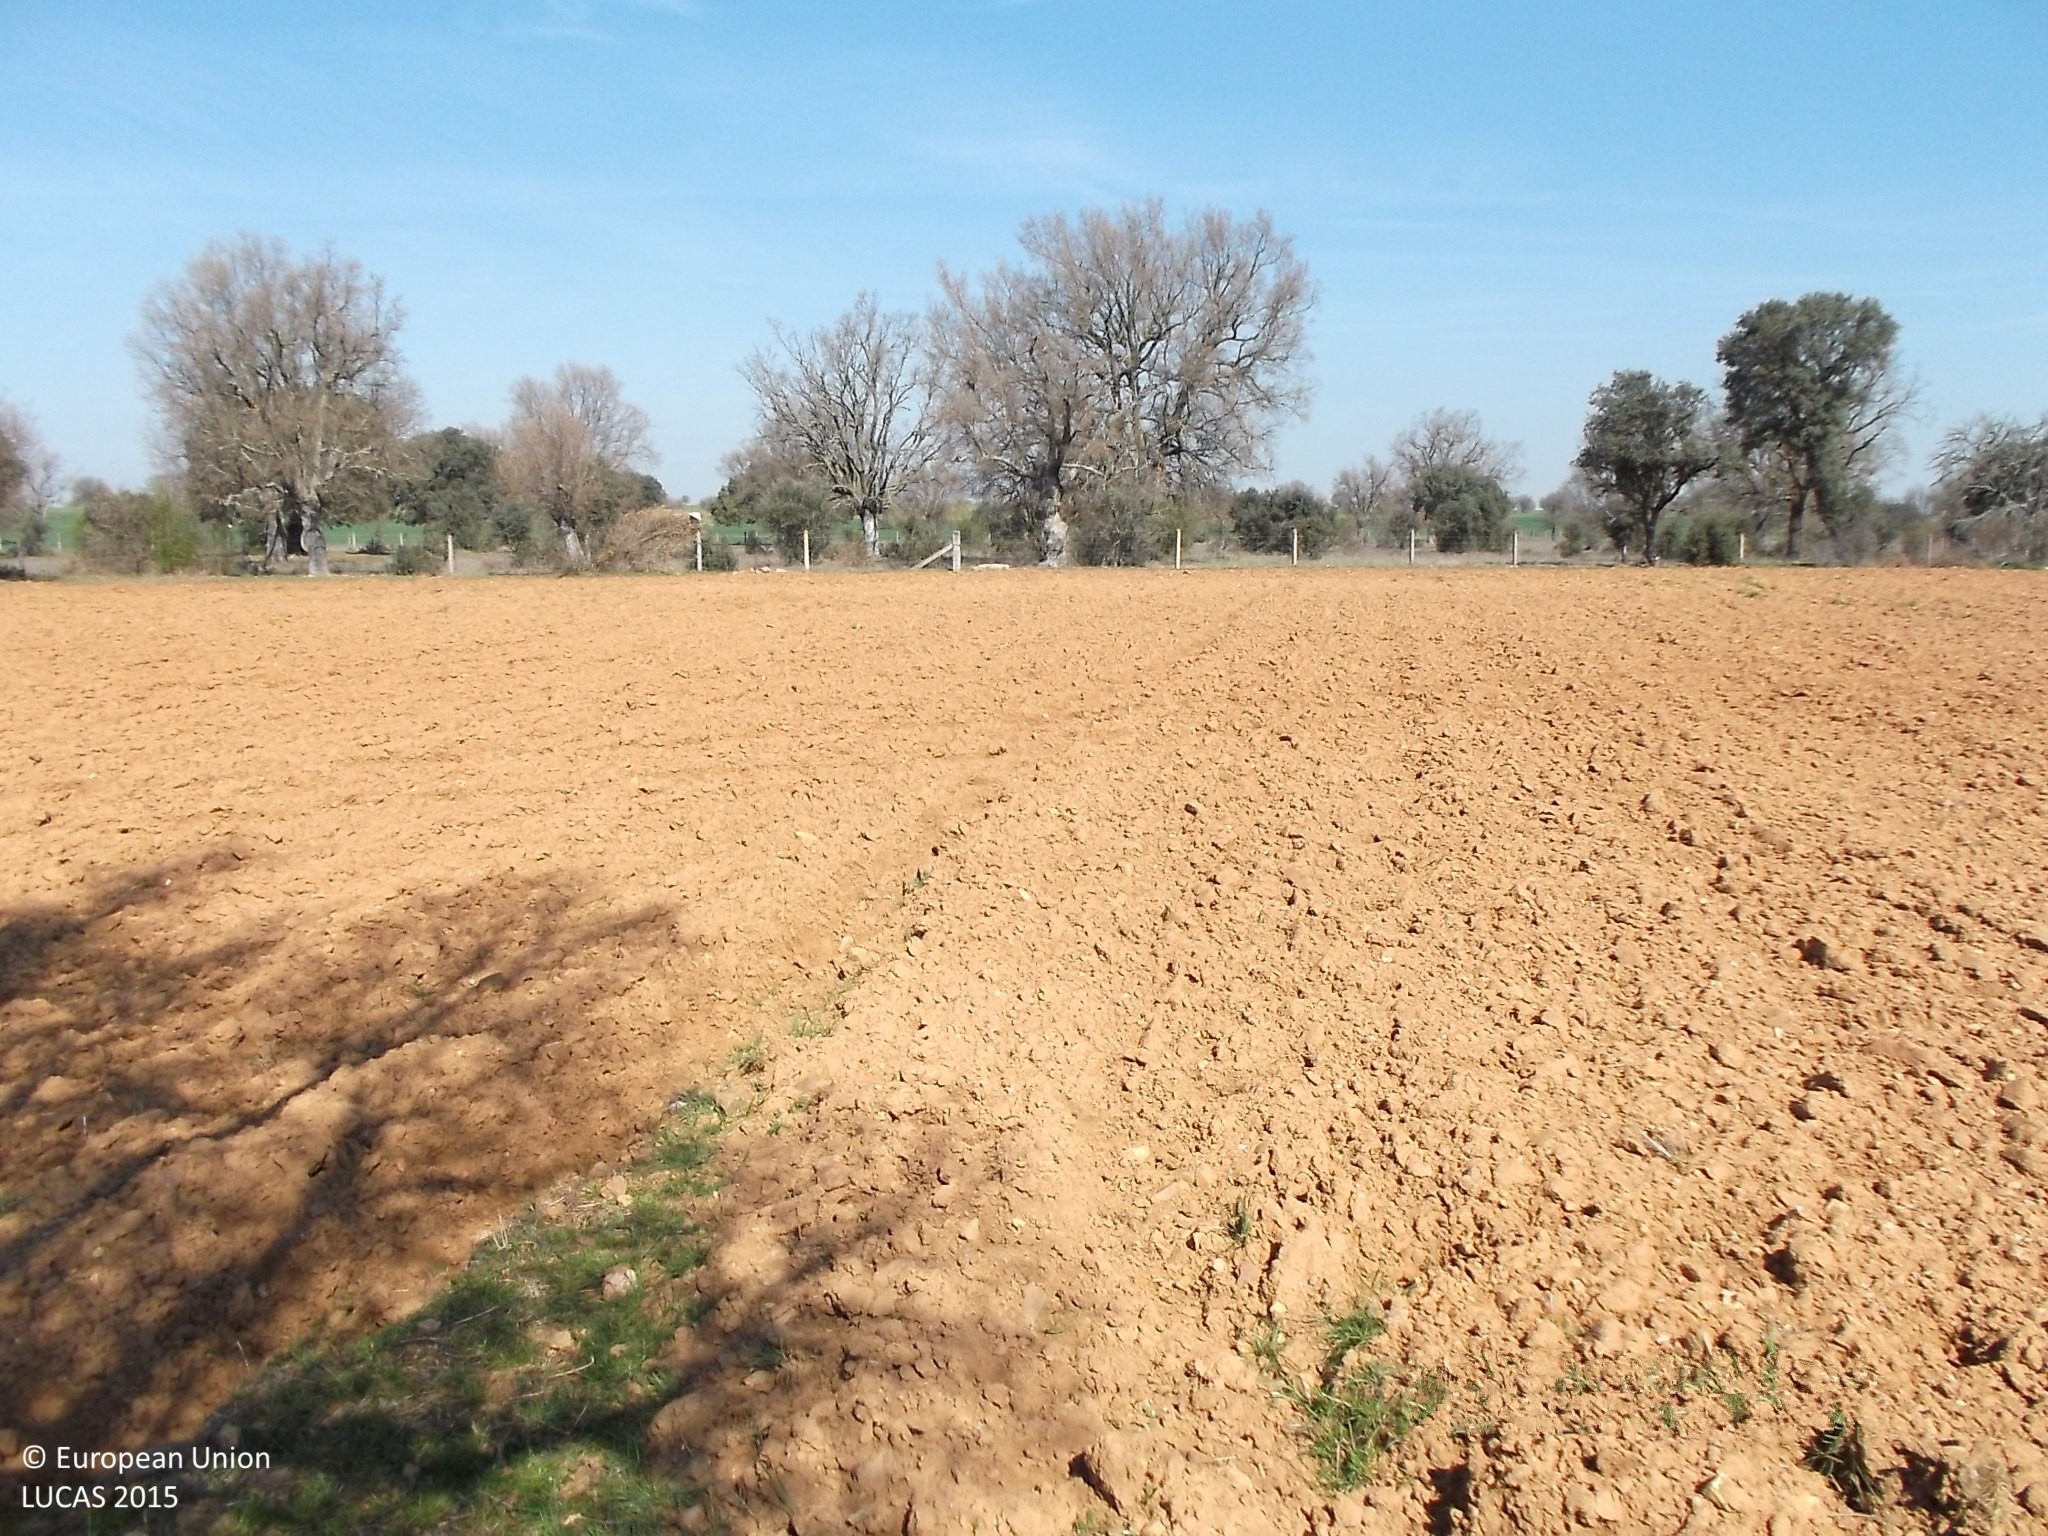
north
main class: Woodland
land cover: Broadleaved woodland
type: broadleaved evergreen forest
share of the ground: 10 - 25 %
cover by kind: unconsolidated bare surface 85 %, broadleaved forest trees 15 %
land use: Forestry
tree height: < 5 m
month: April
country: ES
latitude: 40.8568
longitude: -5.8934
